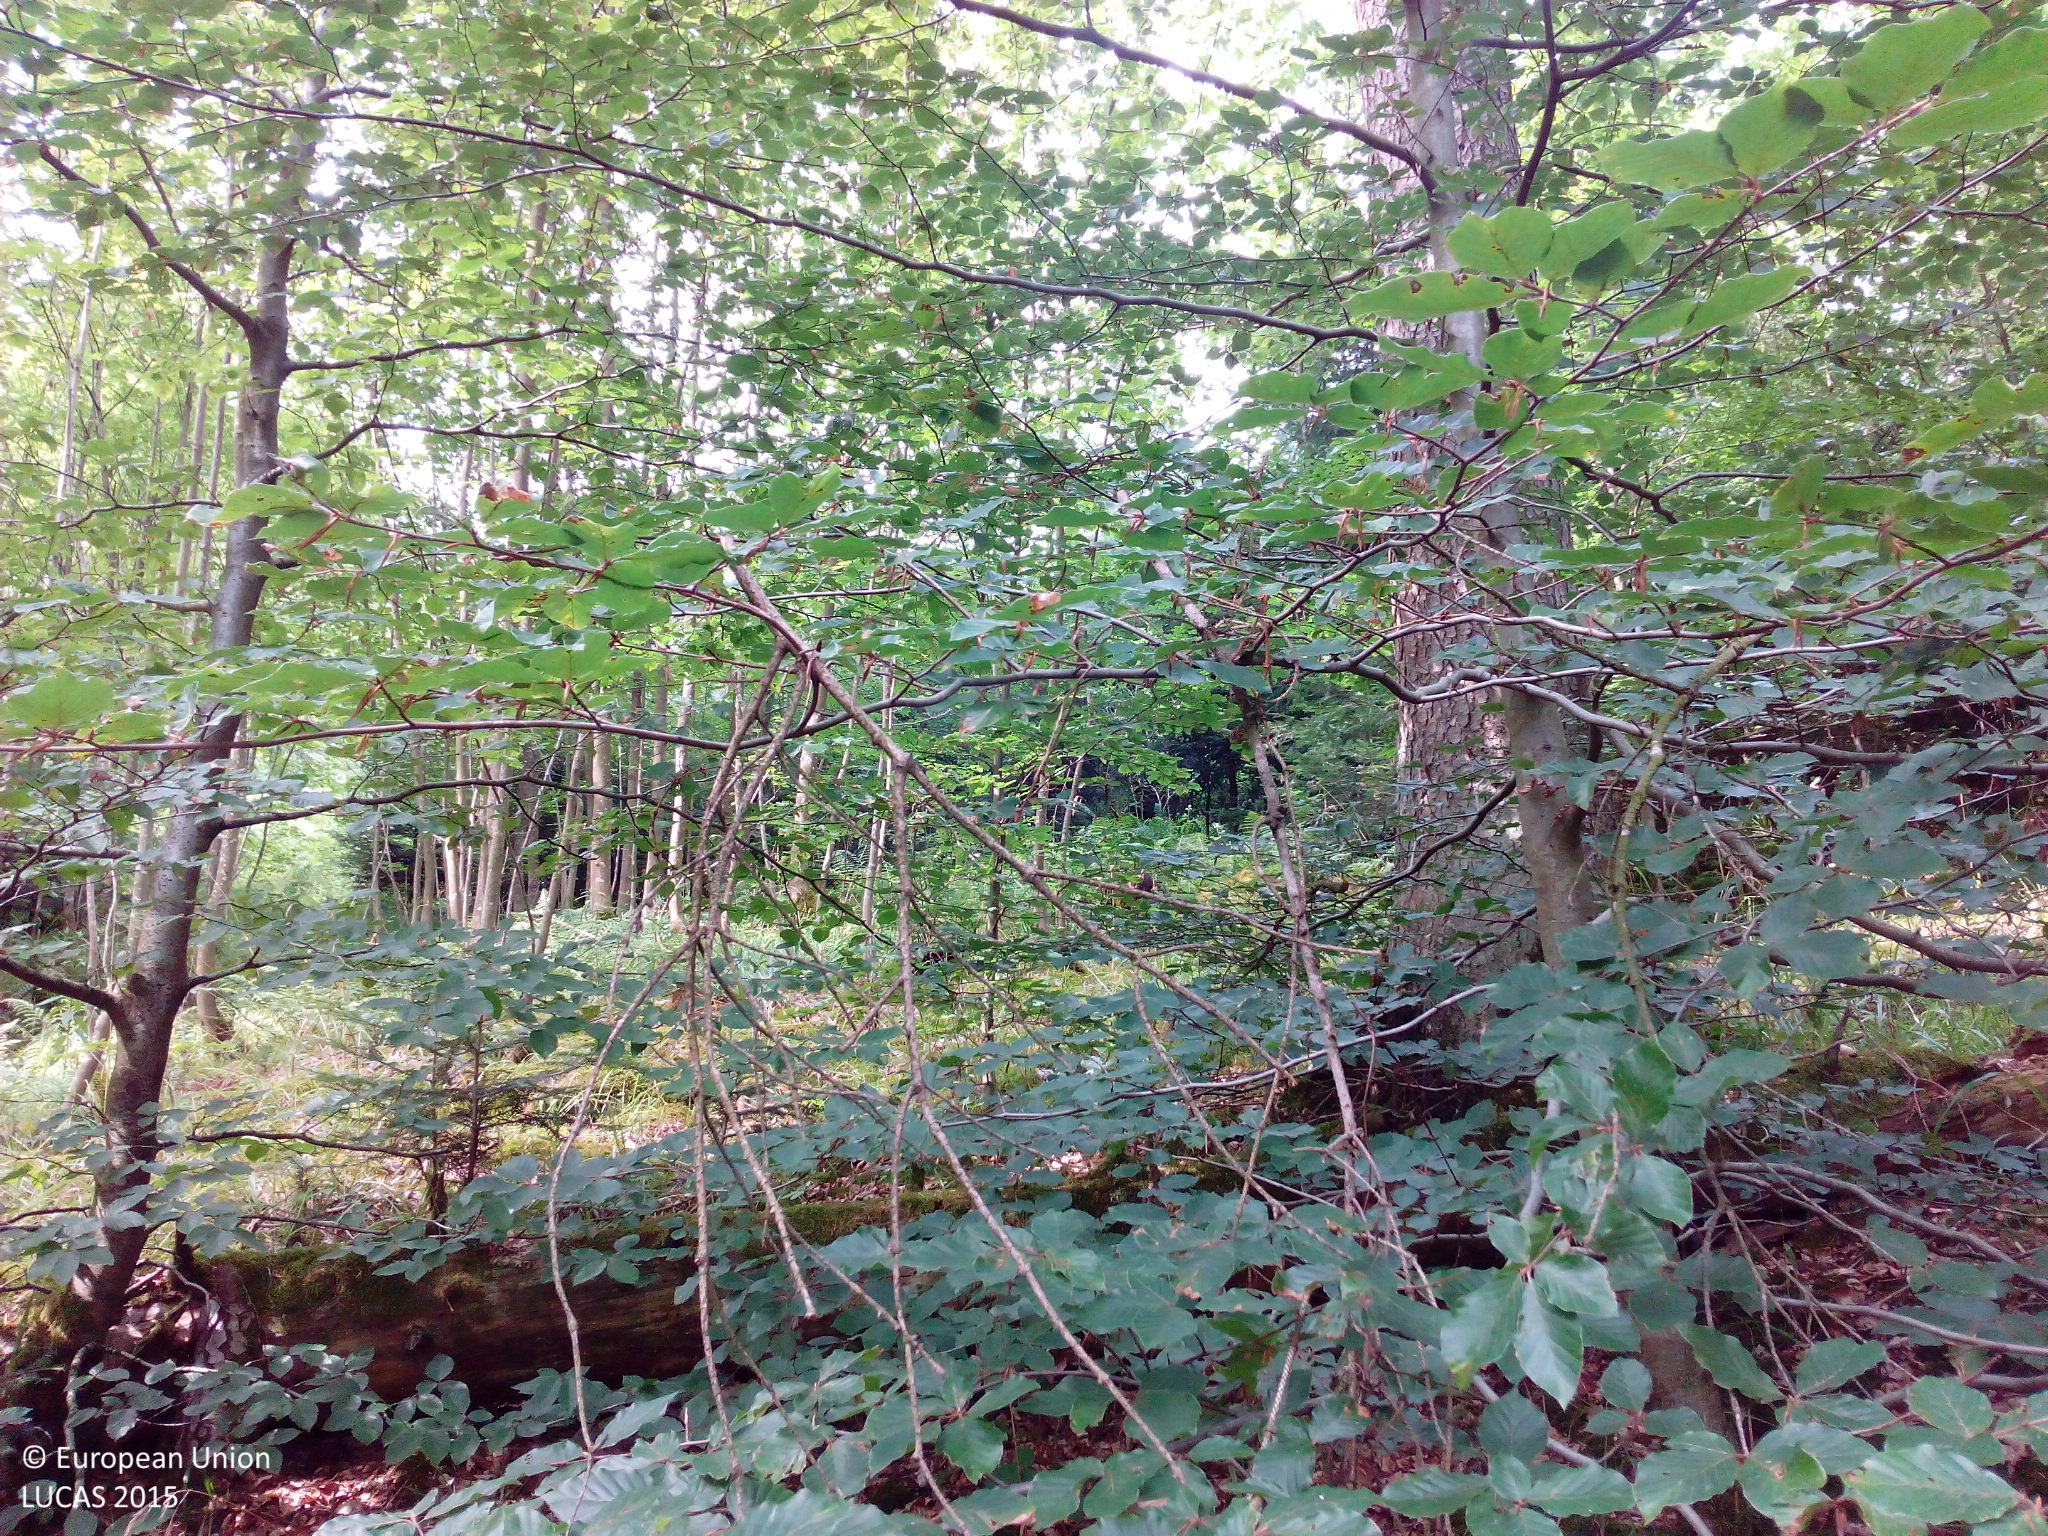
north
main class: Woodland
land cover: Other mixed woodland
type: hemiboreal forest and nemoral coniferous forest and mixed broadleaved-coniferous forest
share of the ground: > 75 %
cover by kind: coniferous forest trees 55 %, broadleaved forest trees 25 %, lichens and mosses 15 %, shrubs 5 %
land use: Forestry
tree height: > 5 m
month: July
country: DE
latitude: 49.0507
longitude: 9.6854
